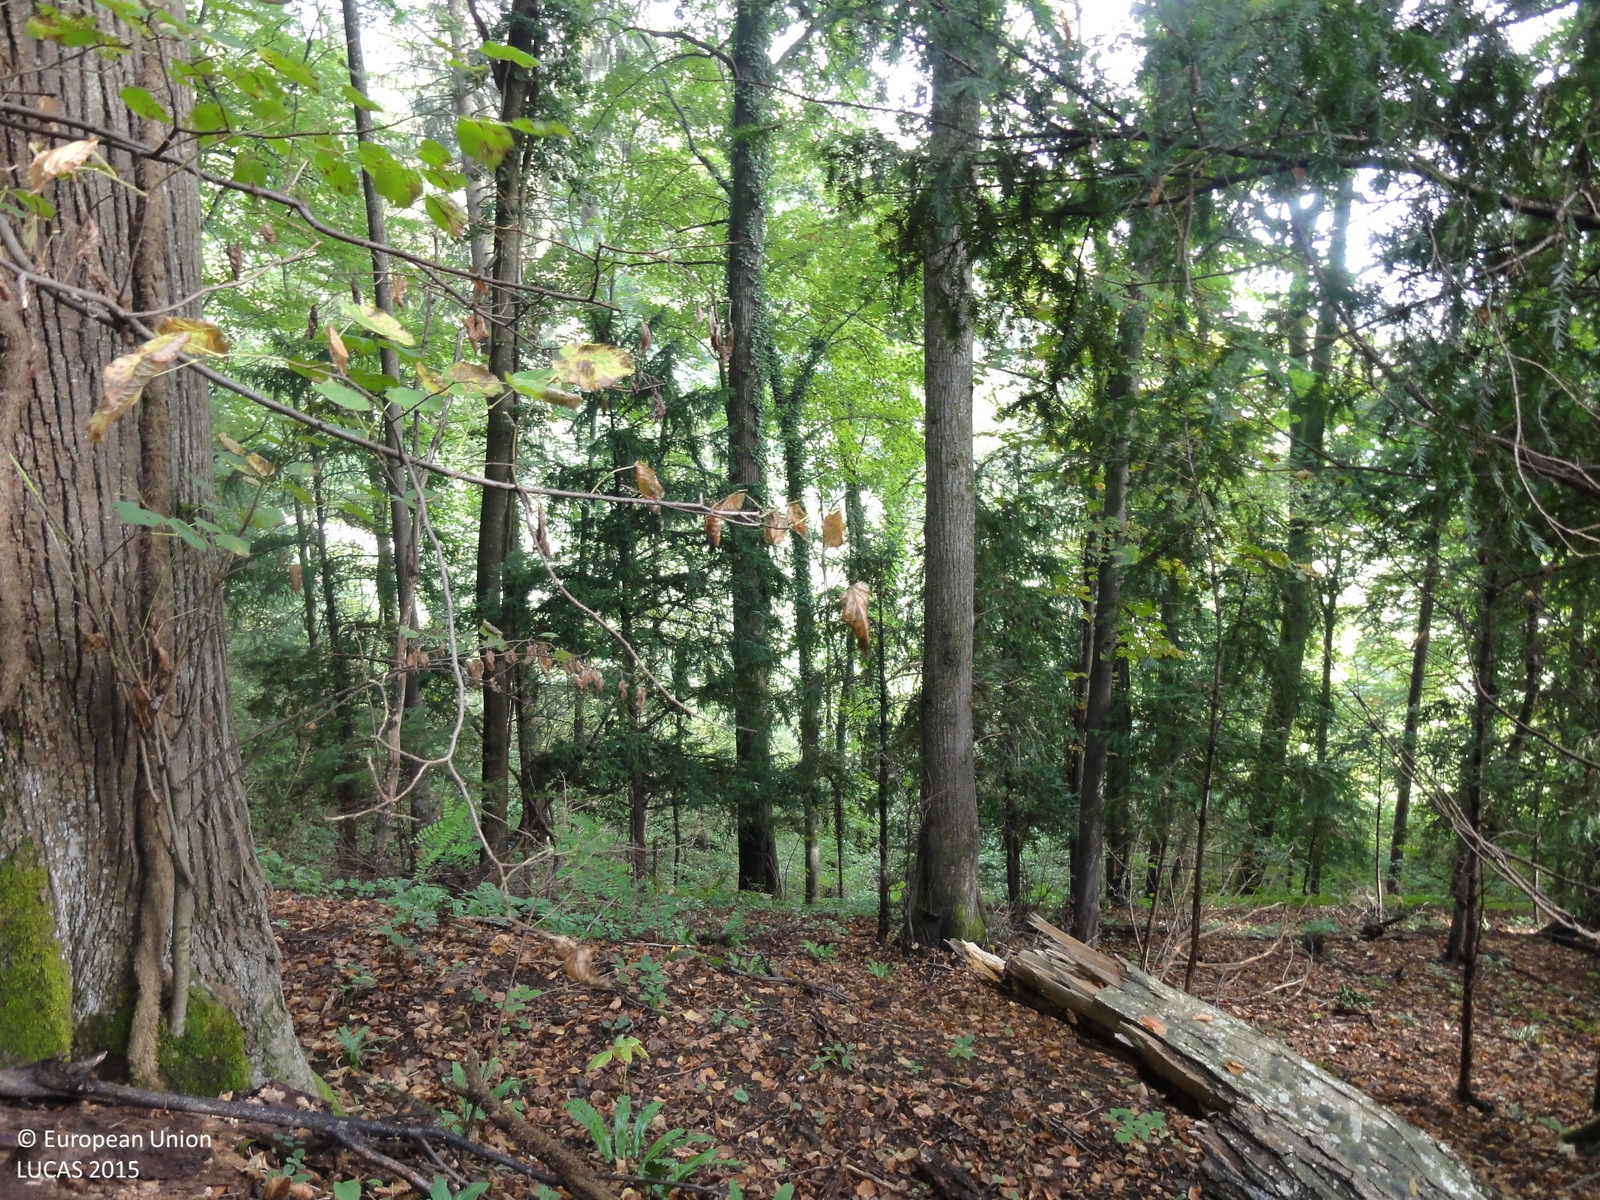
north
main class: Woodland
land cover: Spruce dominated mixed woodland
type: mountainous beech forest
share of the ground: > 75 %
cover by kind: coniferous forest trees 50 %, broadleaved forest trees 50 %
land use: Forestry
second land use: Sport
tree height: > 5 m
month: September
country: SI
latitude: 45.8574
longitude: 15.6772
